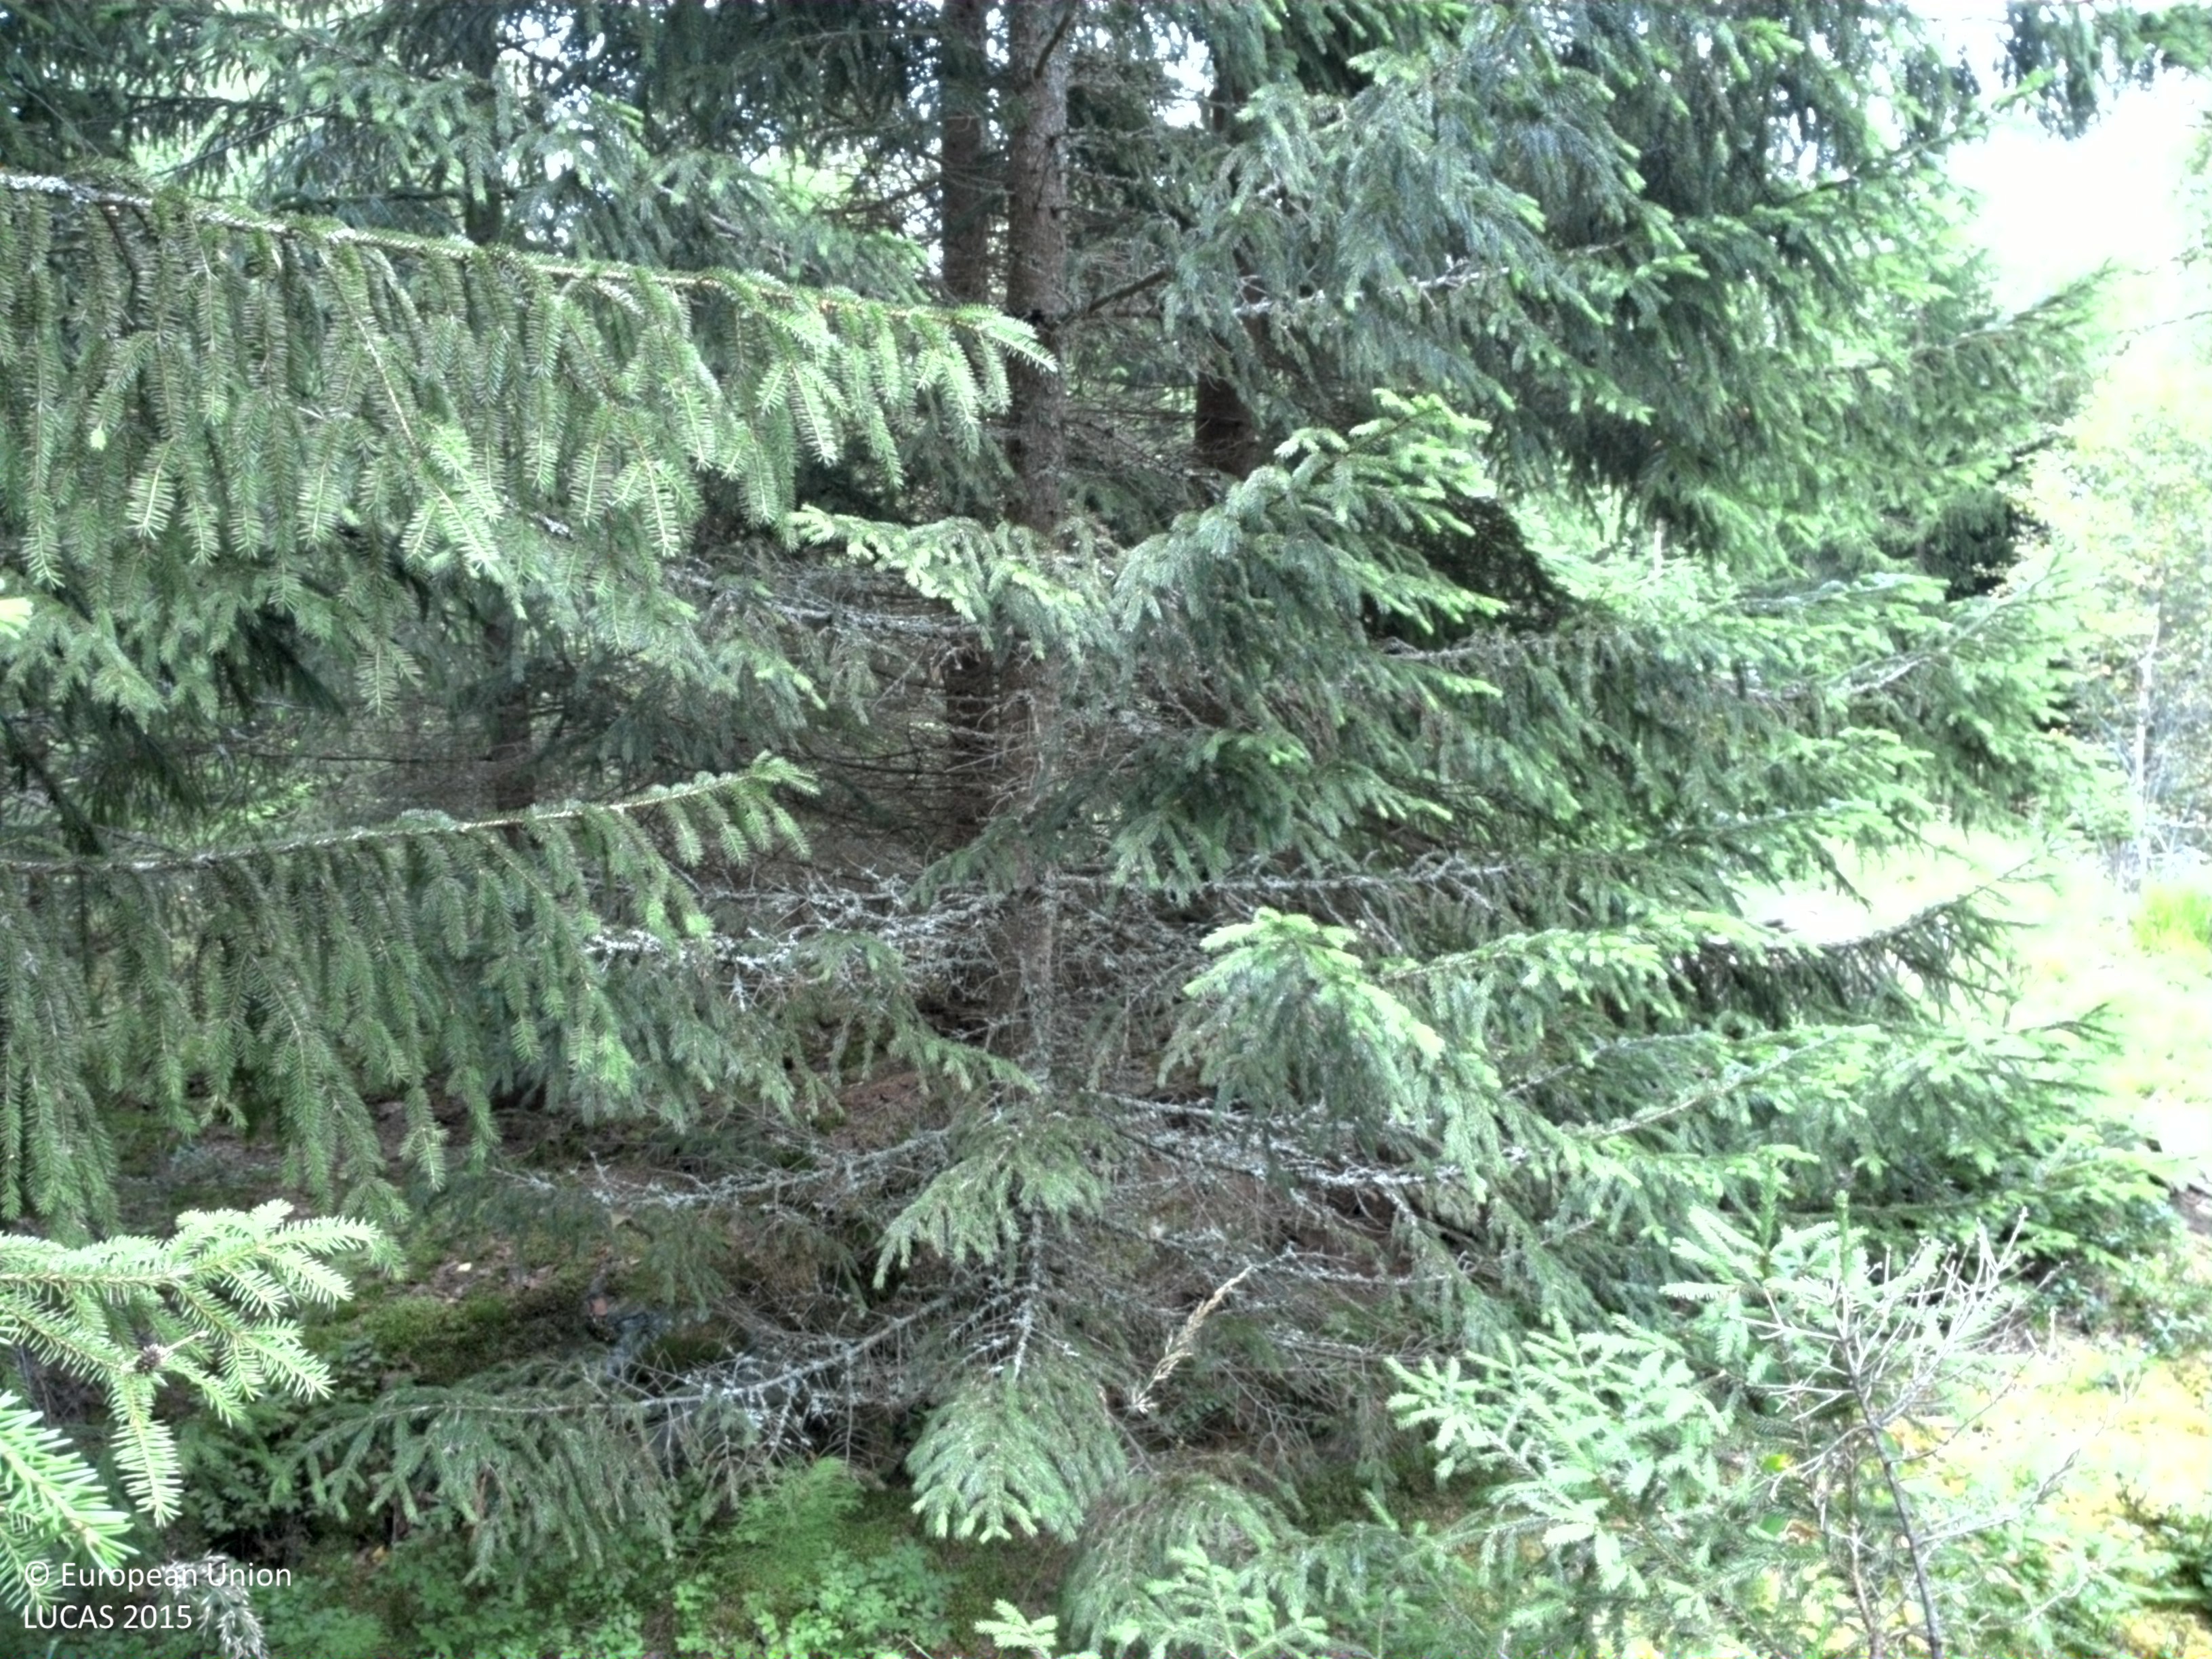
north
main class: Woodland
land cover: Spruce dominated coniferous woodland
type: boreal forest
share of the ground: 50 - 75 %
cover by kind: coniferous forest trees 65 %, broadleaved forest trees 10 %, herbaceous plants 10 %, lichens and mosses 10 %, shrubs 5 %
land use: Forestry
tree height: > 5 m
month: August
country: SE
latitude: 59.8678
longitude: 16.5096
